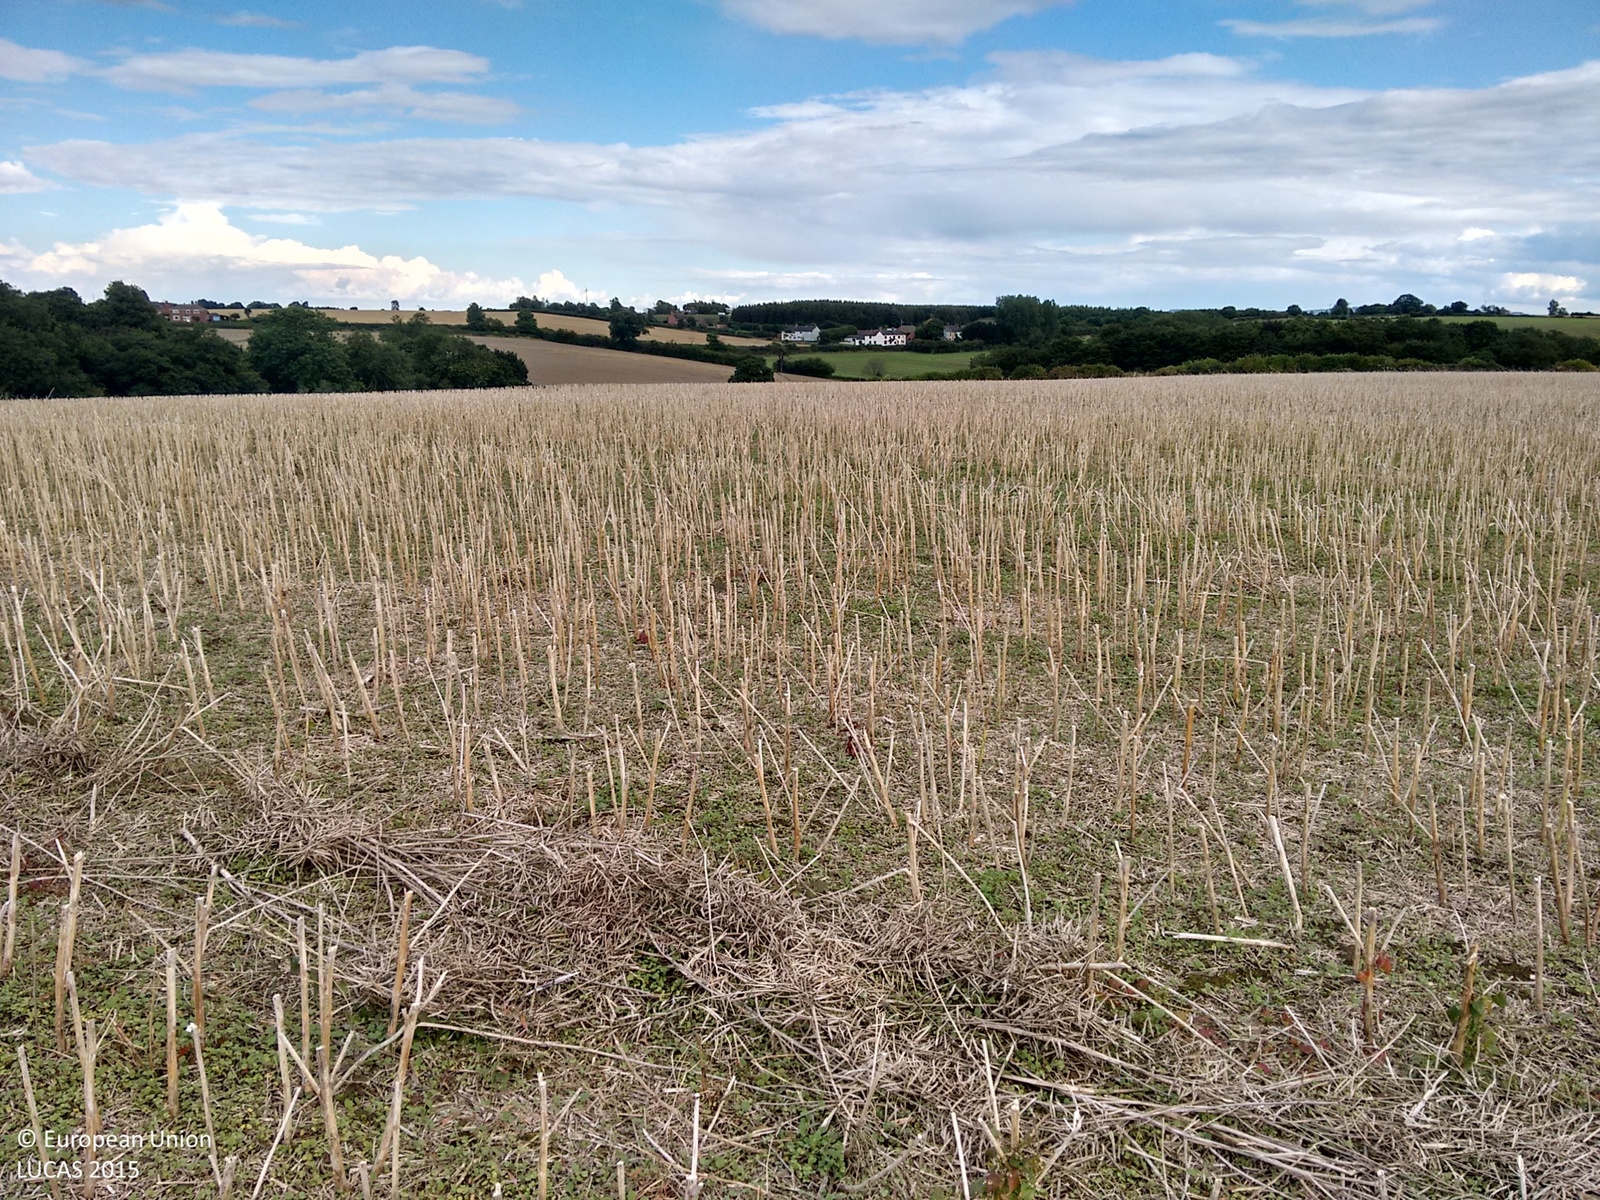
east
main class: Cropland
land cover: Rape and turnip rape
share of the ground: > 75 %
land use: Agriculture (excluding fallow land and kitchen gardens)
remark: Harvested field
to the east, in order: Rape and turnip rape; Grass margins; Managed hedges; Grass margins; Rape and turnip rape
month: September
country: GB
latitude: 52.7606
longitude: -1.5057
